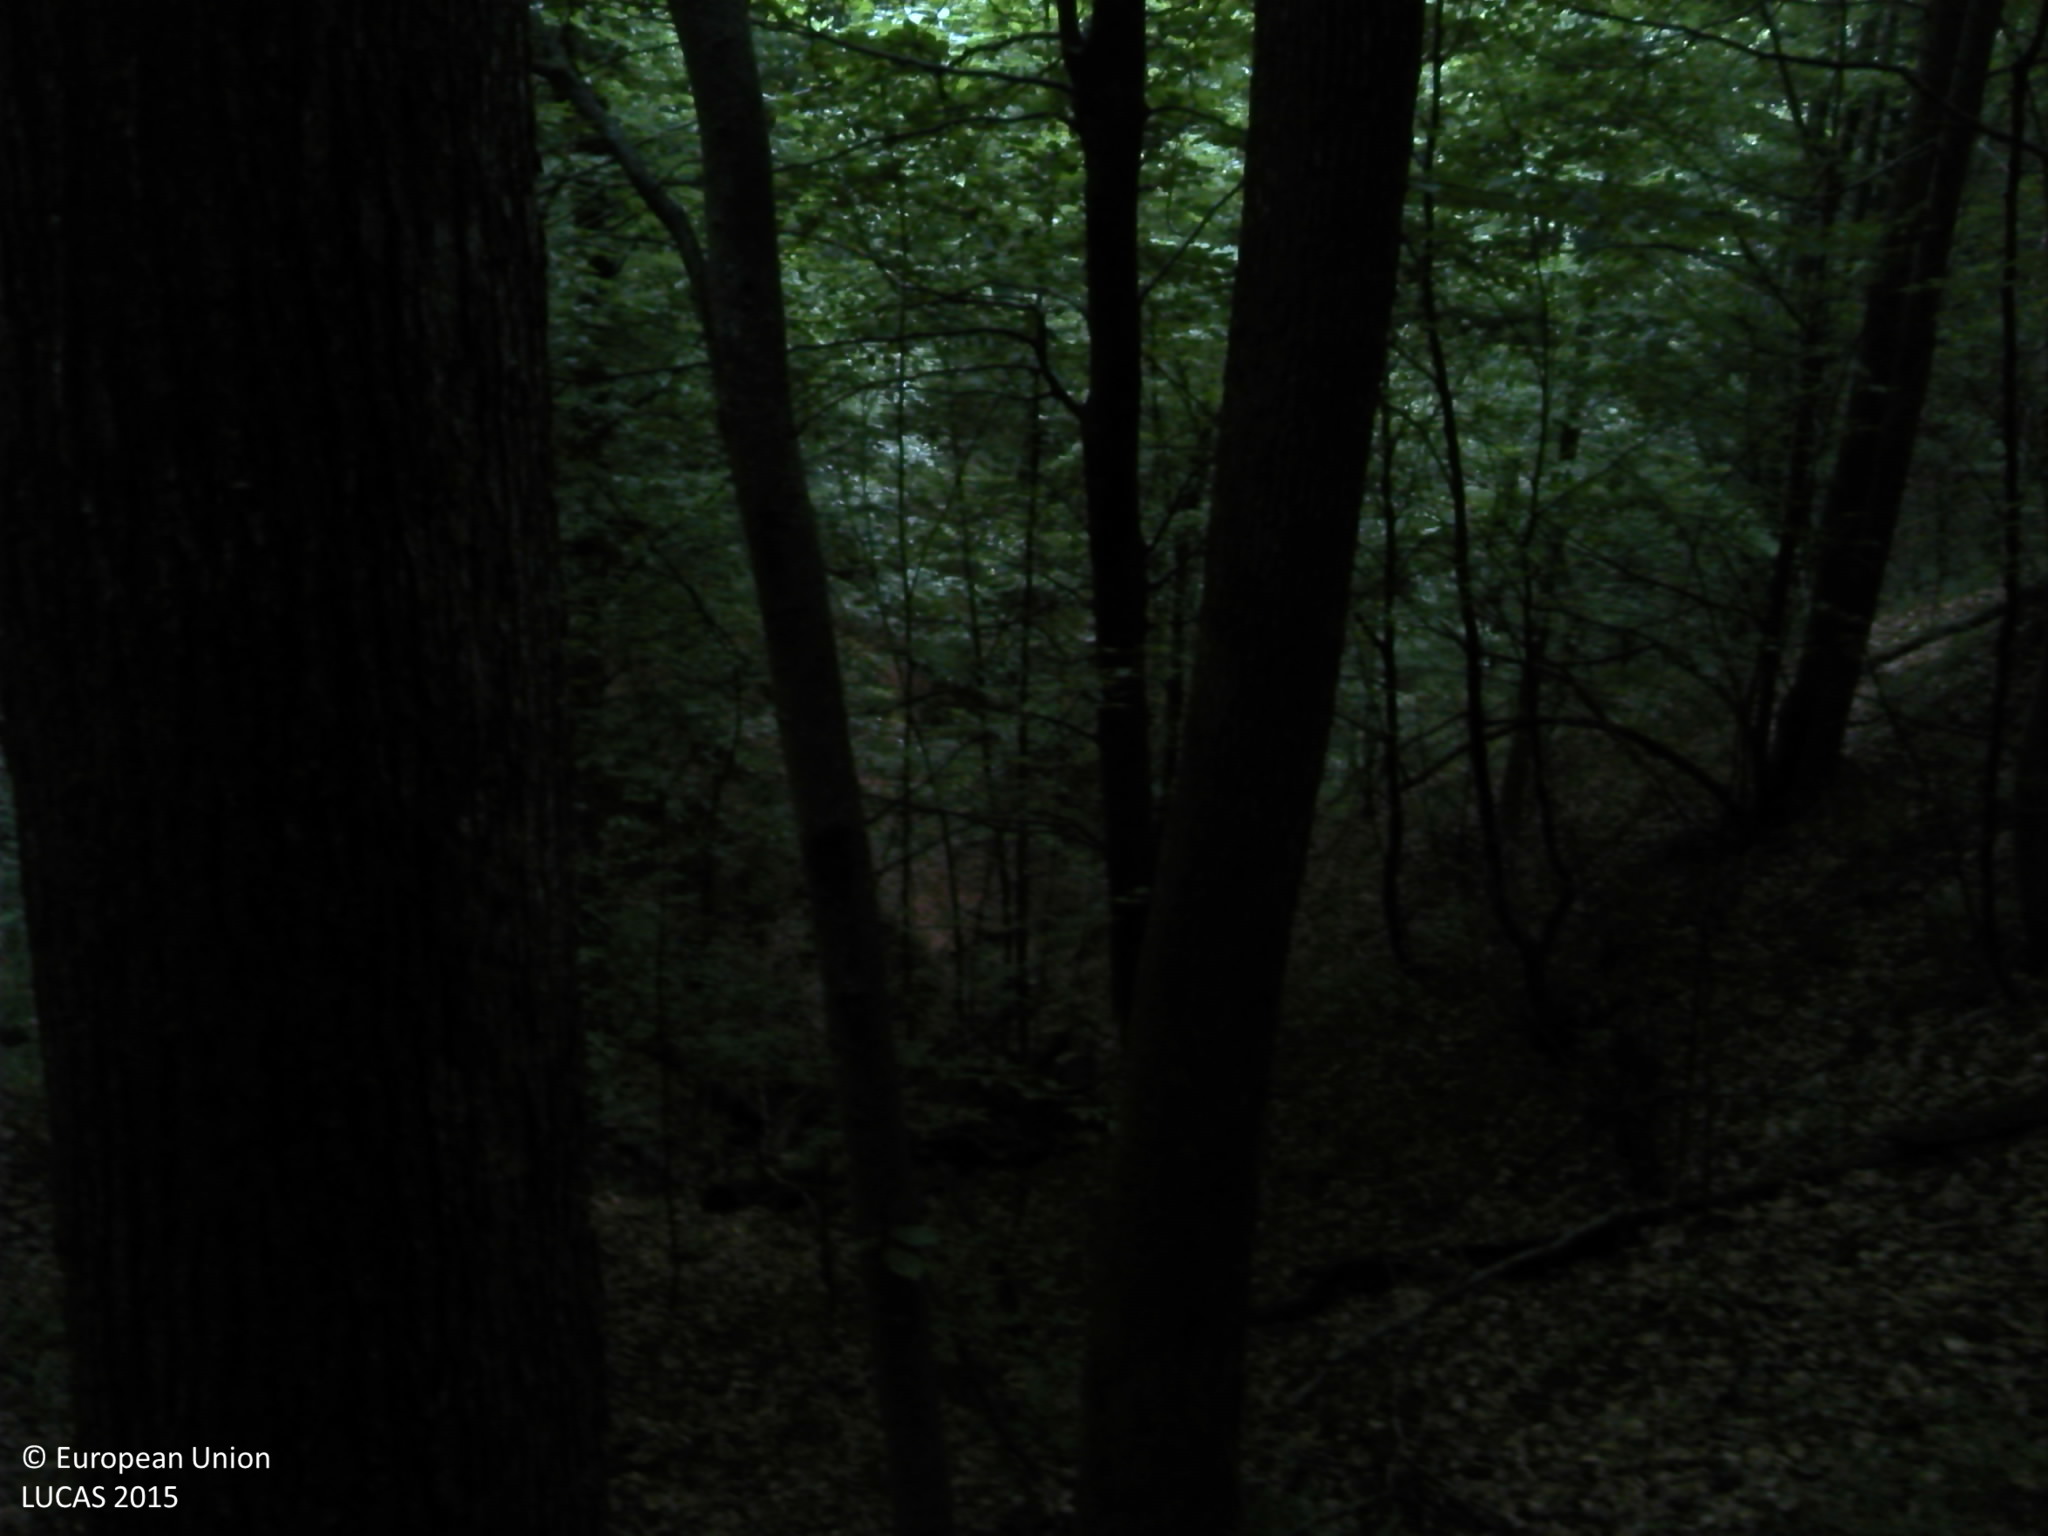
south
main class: Woodland
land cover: Broadleaved woodland
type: acidophilous oak and oak-birch forest
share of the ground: > 75 %
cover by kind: broadleaved forest trees 100 %
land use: Forestry
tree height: > 5 m
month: June
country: HR
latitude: 45.5257
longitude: 17.5173
